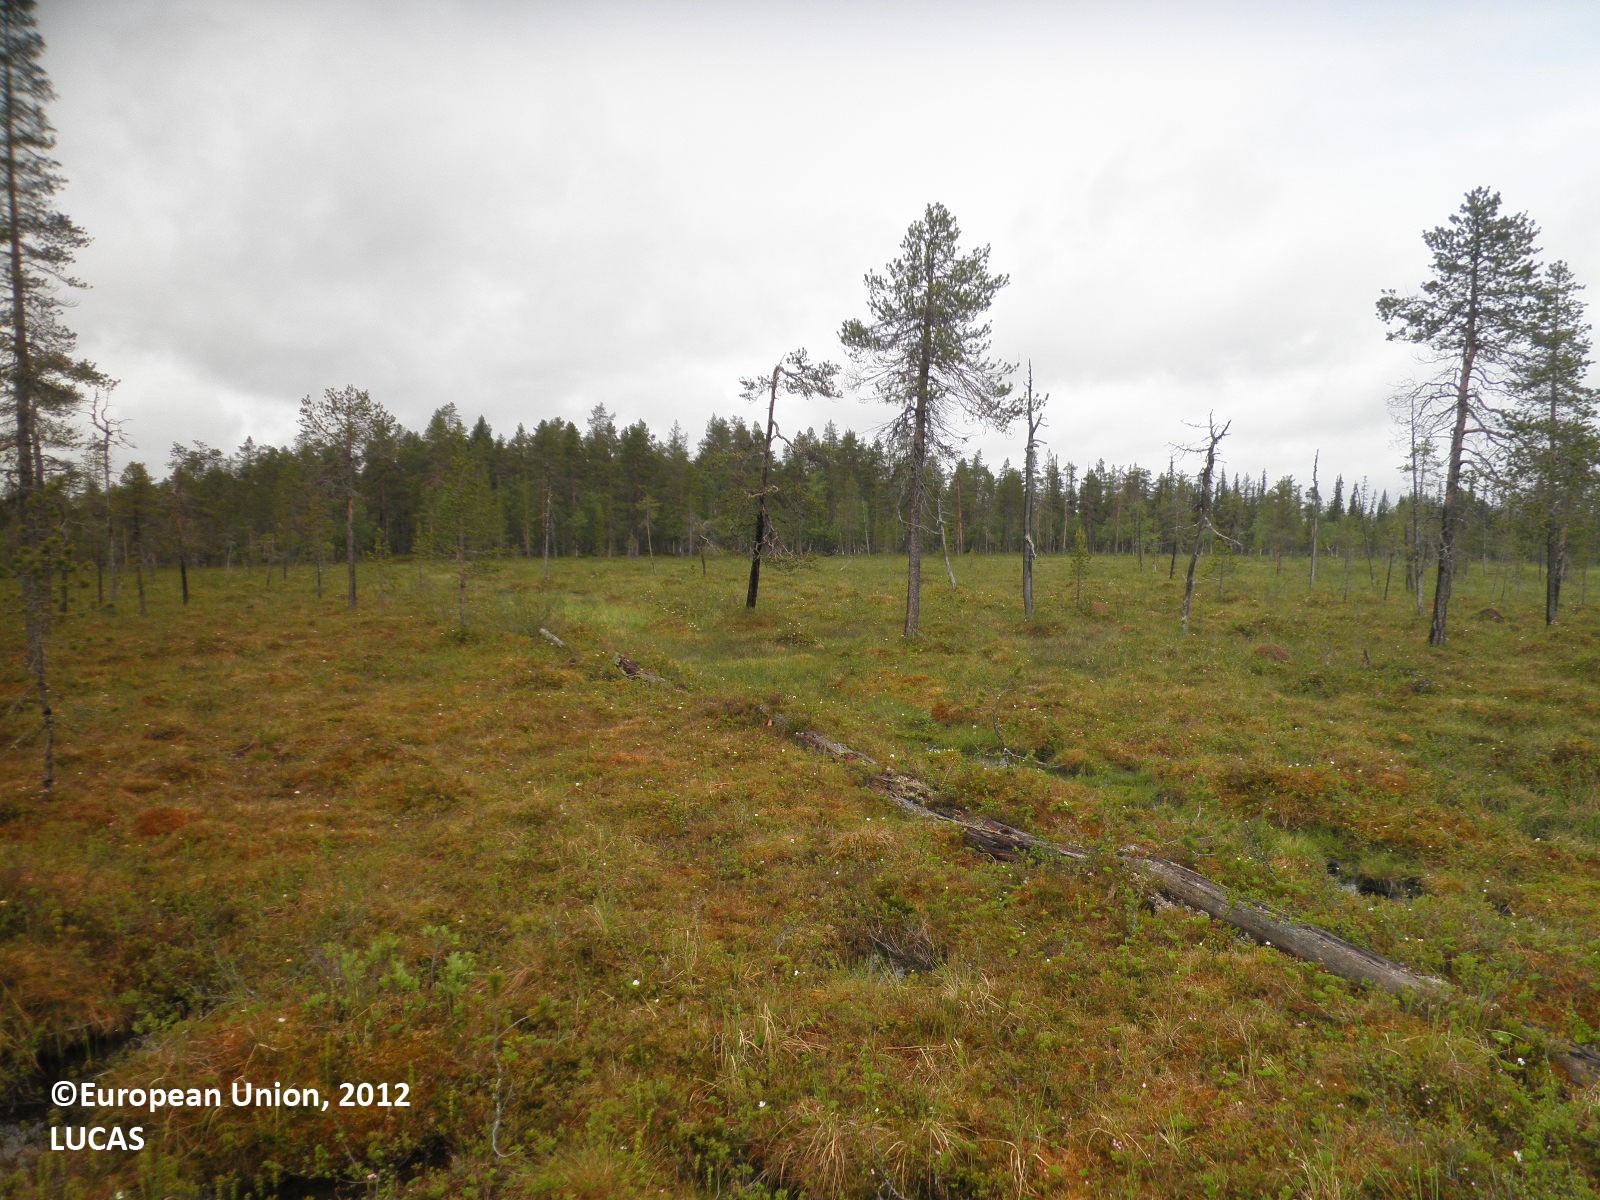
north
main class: Woodland
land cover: Pine dominated coniferous woodland
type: boreal forest
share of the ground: 10 - 25 %
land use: Forestry
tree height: > 5 m
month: June
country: FI
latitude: 68.3992
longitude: 26.4859
